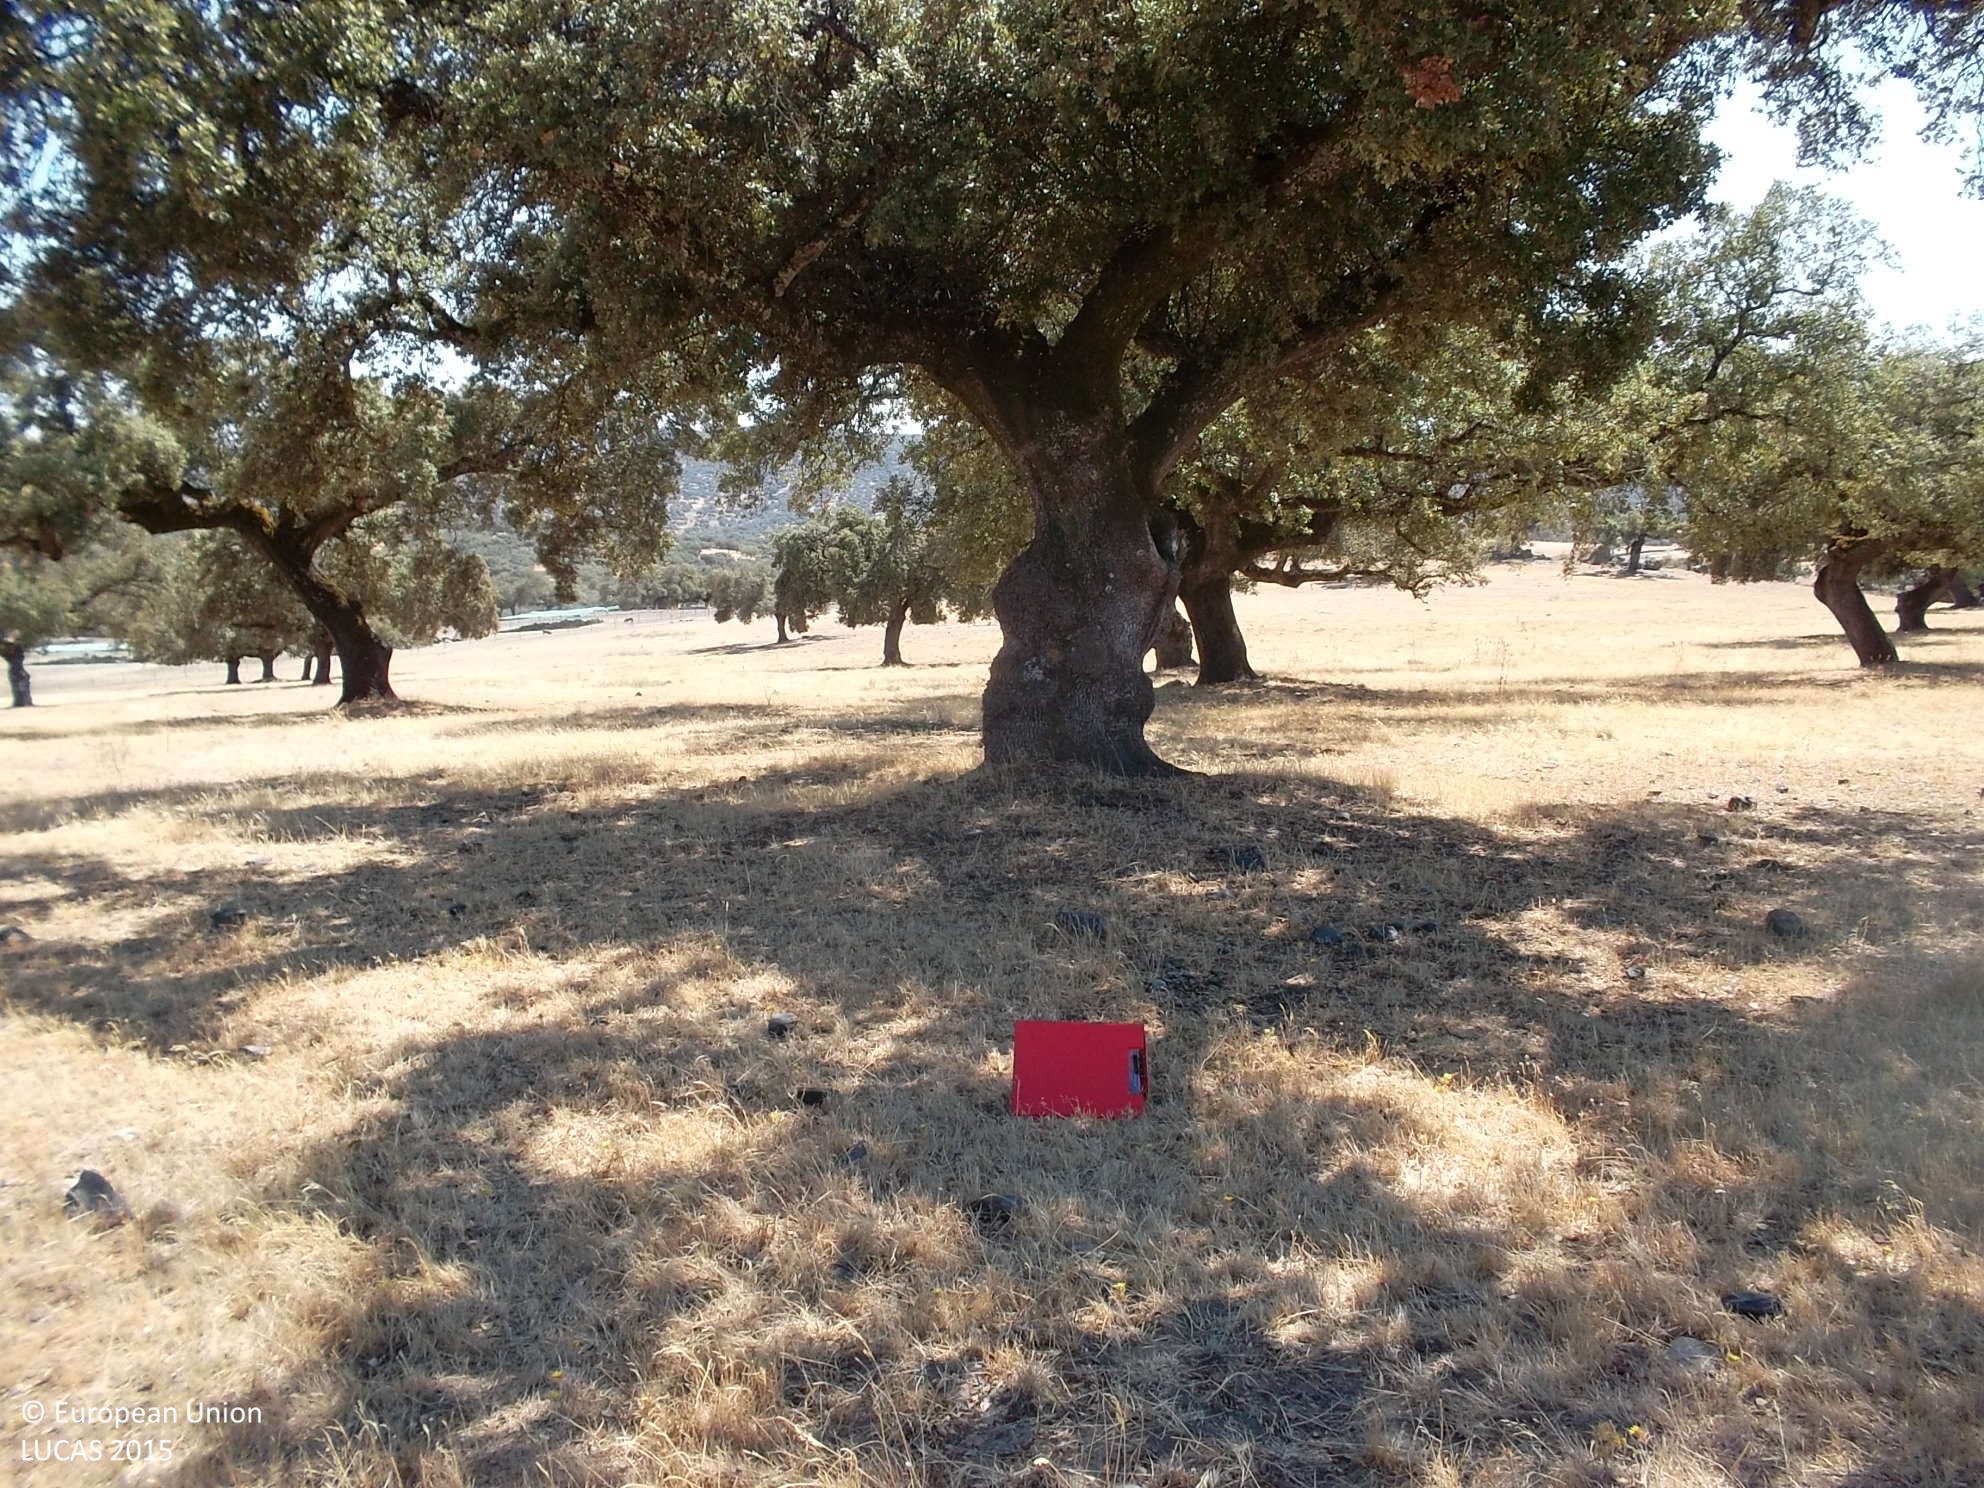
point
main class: Woodland
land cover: Broadleaved woodland
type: broadleaved evergreen forest
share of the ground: 10 - 25 %
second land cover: Grassland without tree/shrub cover
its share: > 75 %
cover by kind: herbaceous plants 85 %, broadleaved forest trees 15 %
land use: Forestry
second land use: Agriculture (excluding fallow land and kitchen gardens)
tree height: > 5 m
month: August
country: ES
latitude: 38.4330
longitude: -6.7247
